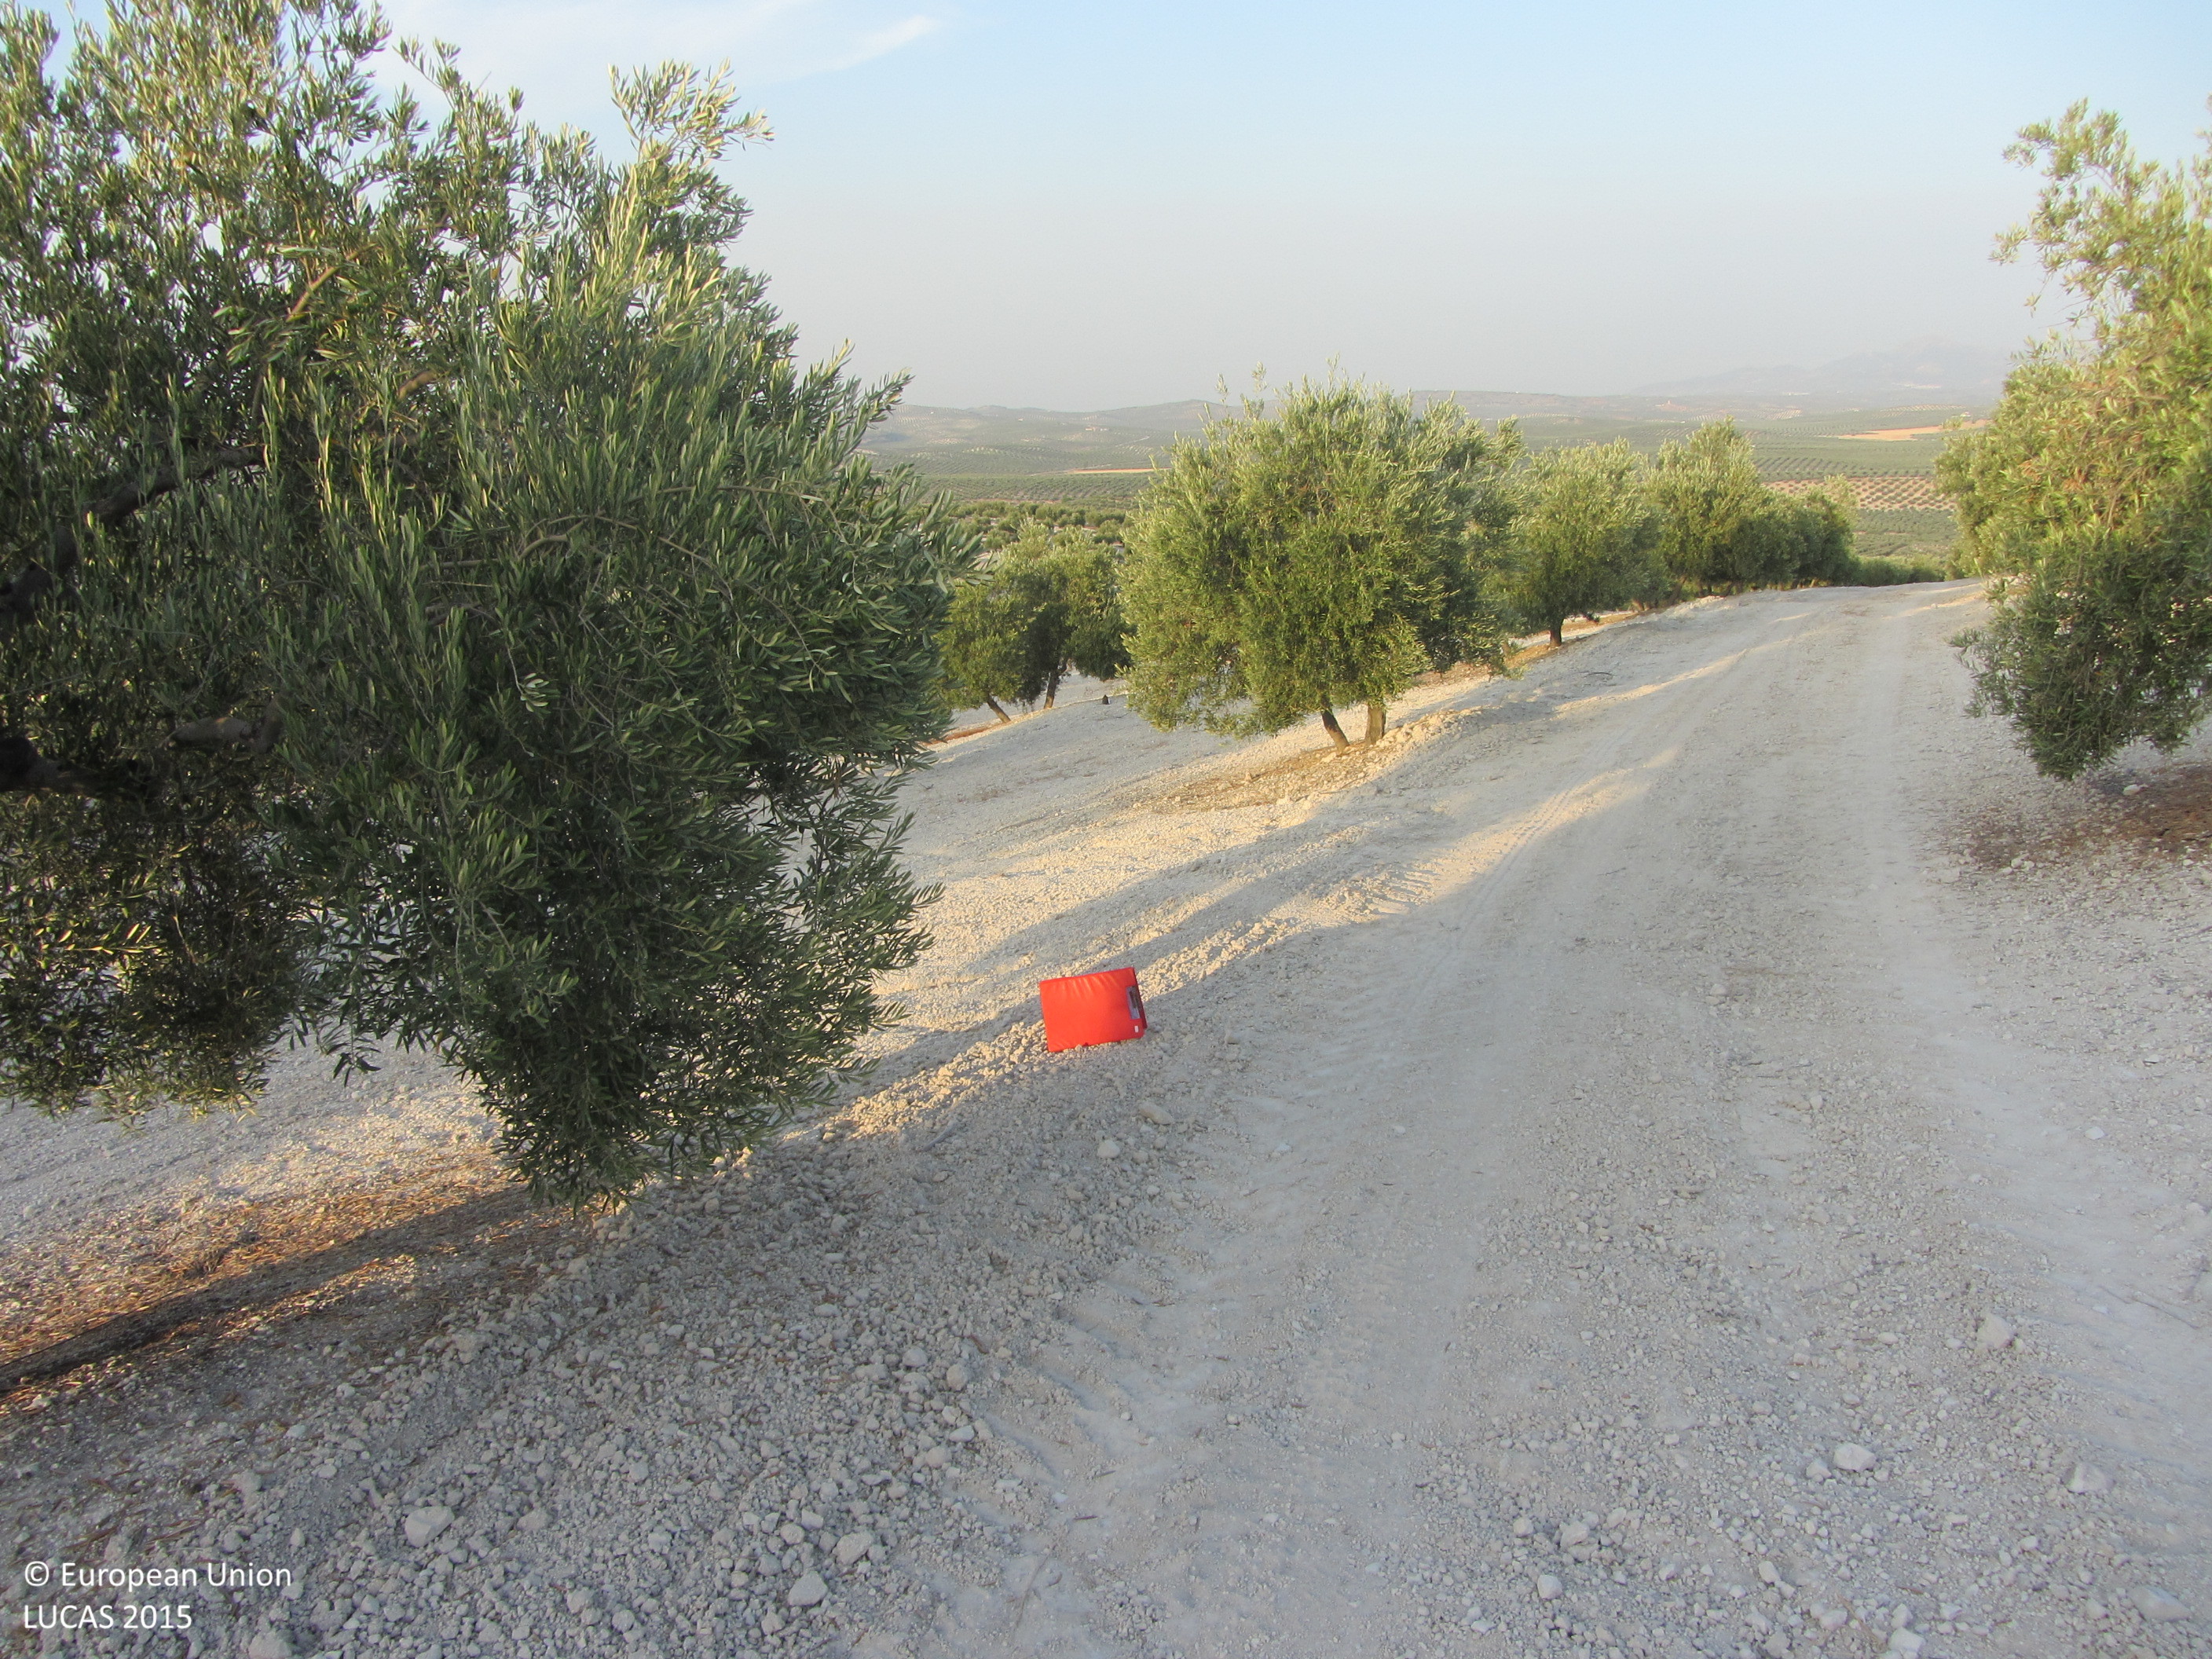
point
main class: Cropland
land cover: Olive groves
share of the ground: 10 - 25 %
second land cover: Other bare soil
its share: > 75 %
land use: Agriculture (excluding fallow land and kitchen gardens)
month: July
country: ES
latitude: 37.7840
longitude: -4.1643
